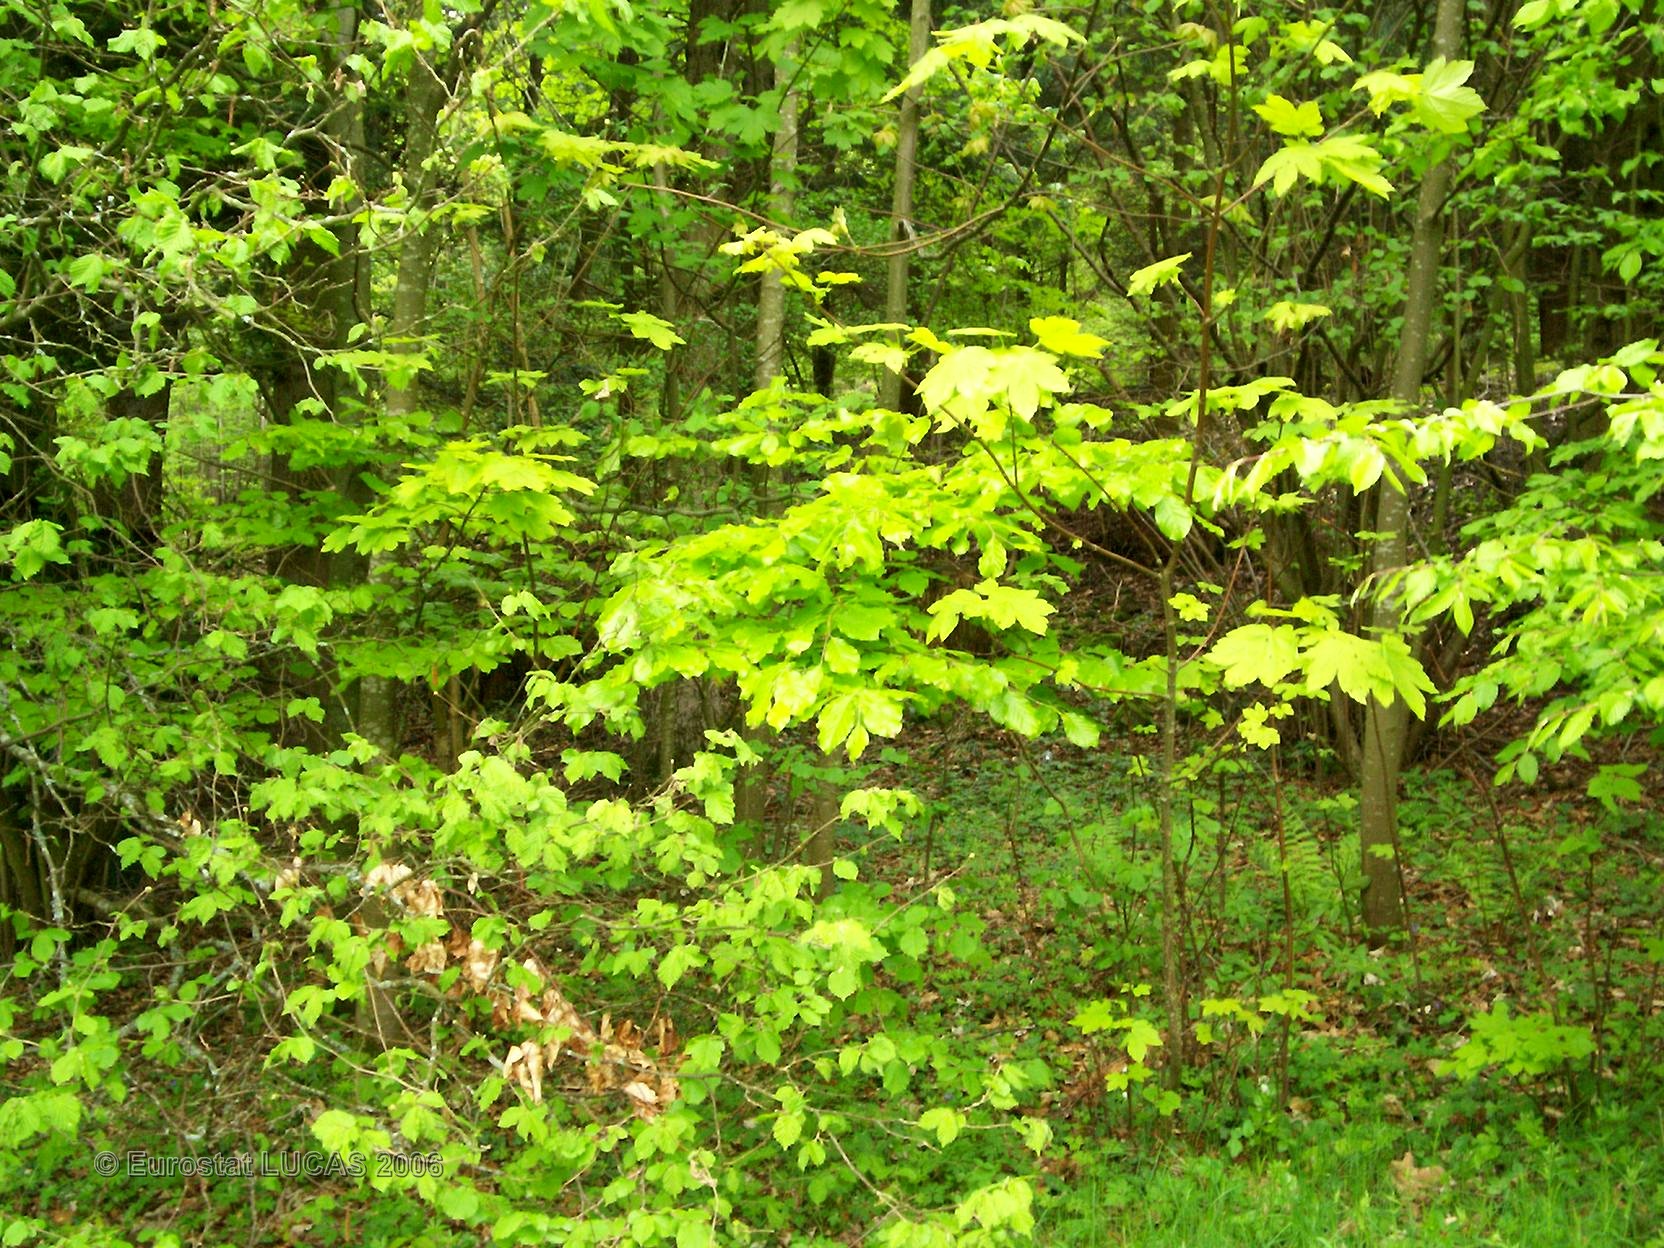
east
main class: Grassland
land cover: Grassland with sparse tree/shrub cover
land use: Agriculture (excluding fallow land and kitchen gardens)
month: May
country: FR
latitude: 47.8987
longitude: 7.1521
